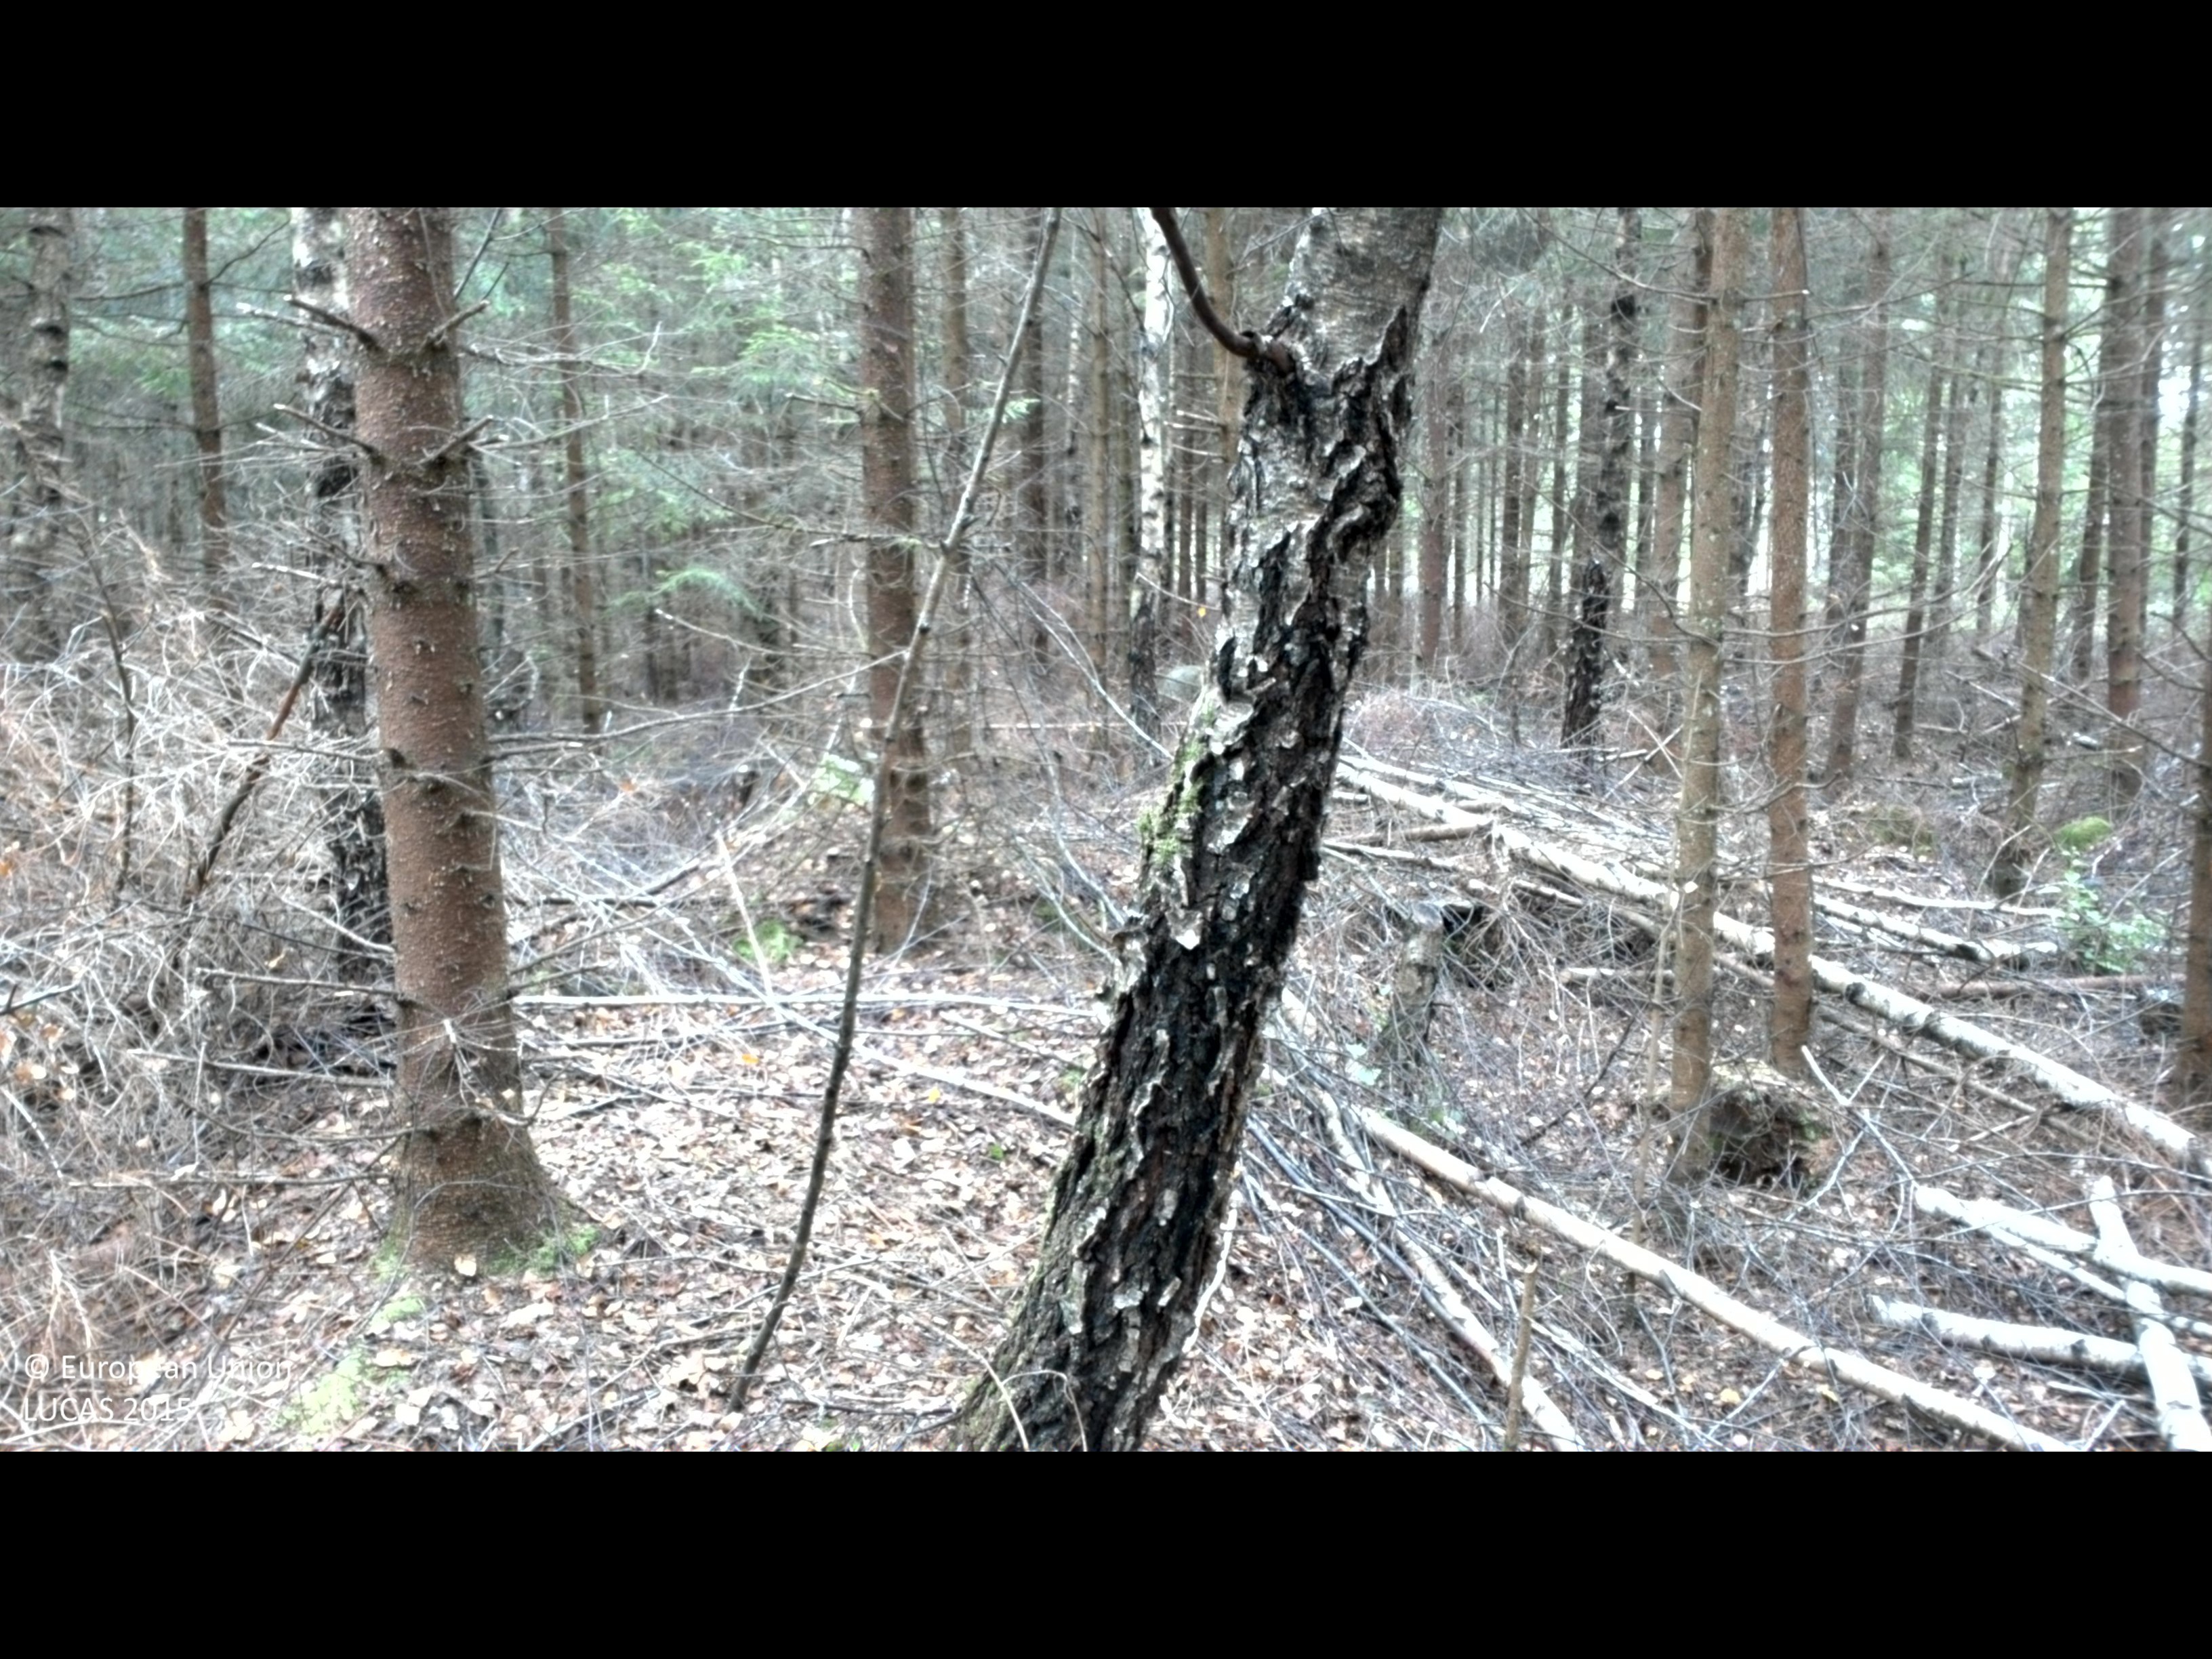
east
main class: Woodland
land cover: Spruce dominated mixed woodland
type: boreal forest
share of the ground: 50 - 75 %
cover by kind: coniferous forest trees 50 %, broadleaved forest trees 20 %
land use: Forestry
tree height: > 5 m
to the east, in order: Spruce dominated mixed woodland; Grass margins; Paved roads, cycling and walking lanes; Grass margins; Groves; Spruce dominated coniferous woodland; Ditches and canals; Spruce dominated coniferous woodland
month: August
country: SE
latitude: 56.3356
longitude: 14.1869
